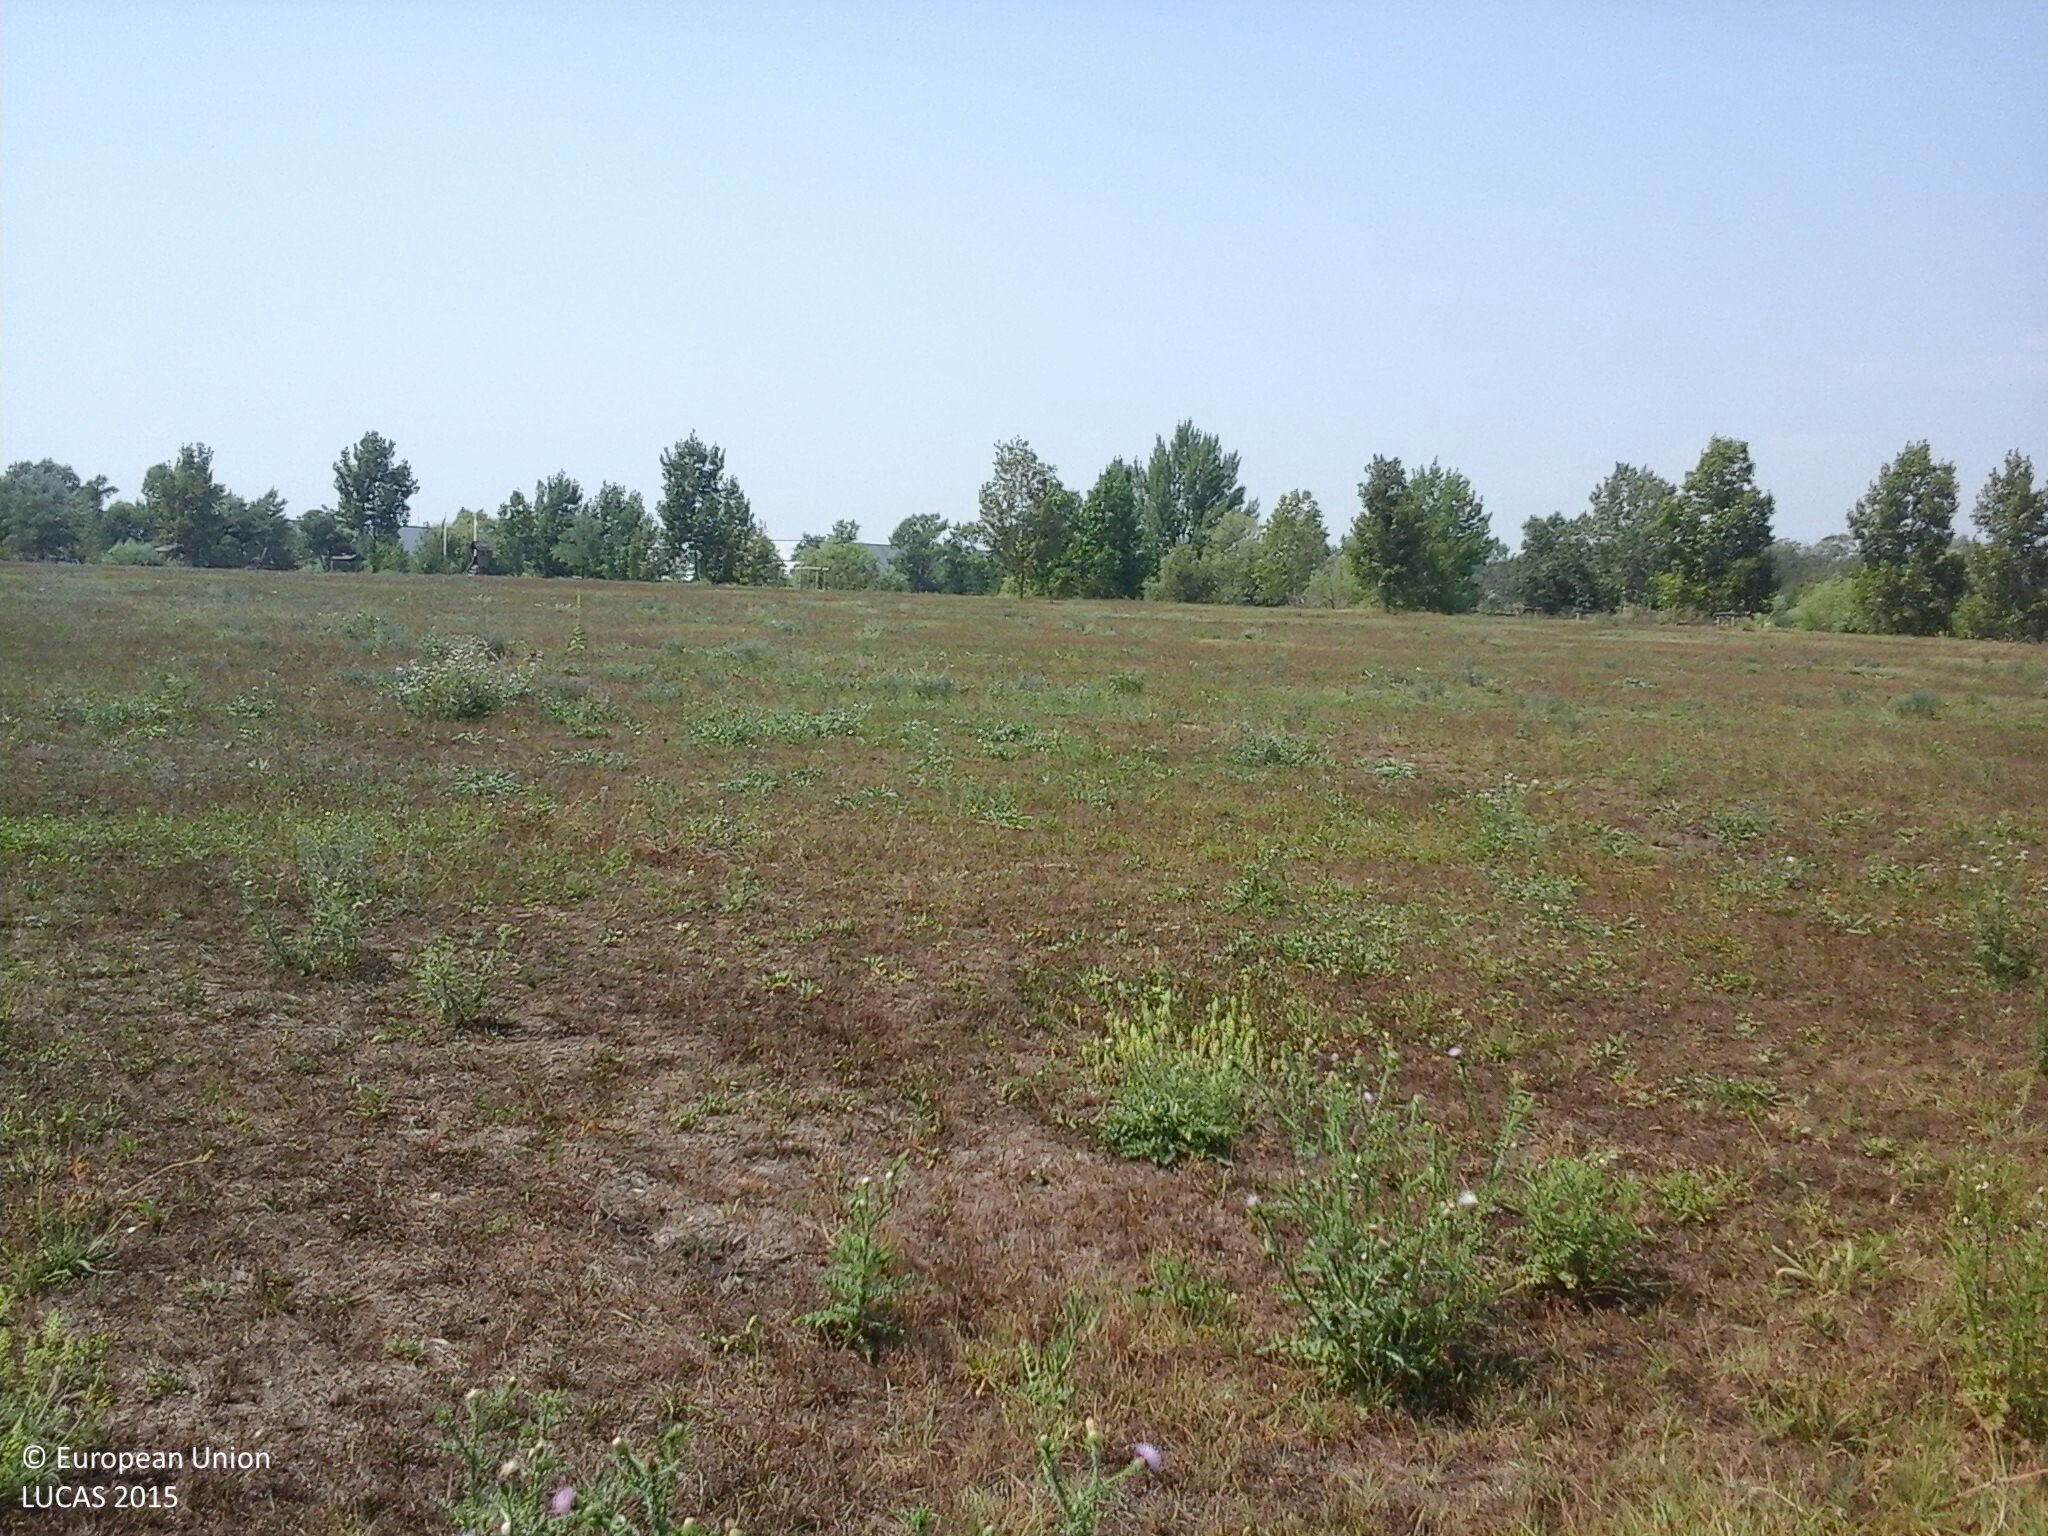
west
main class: Grassland
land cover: Spontaneously vegetated surfaces
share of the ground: > 75 %
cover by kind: herbaceous plants 100 %
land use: Semi-natural and natural areas not in use
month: August
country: HU
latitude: 47.3676
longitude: 19.1952
